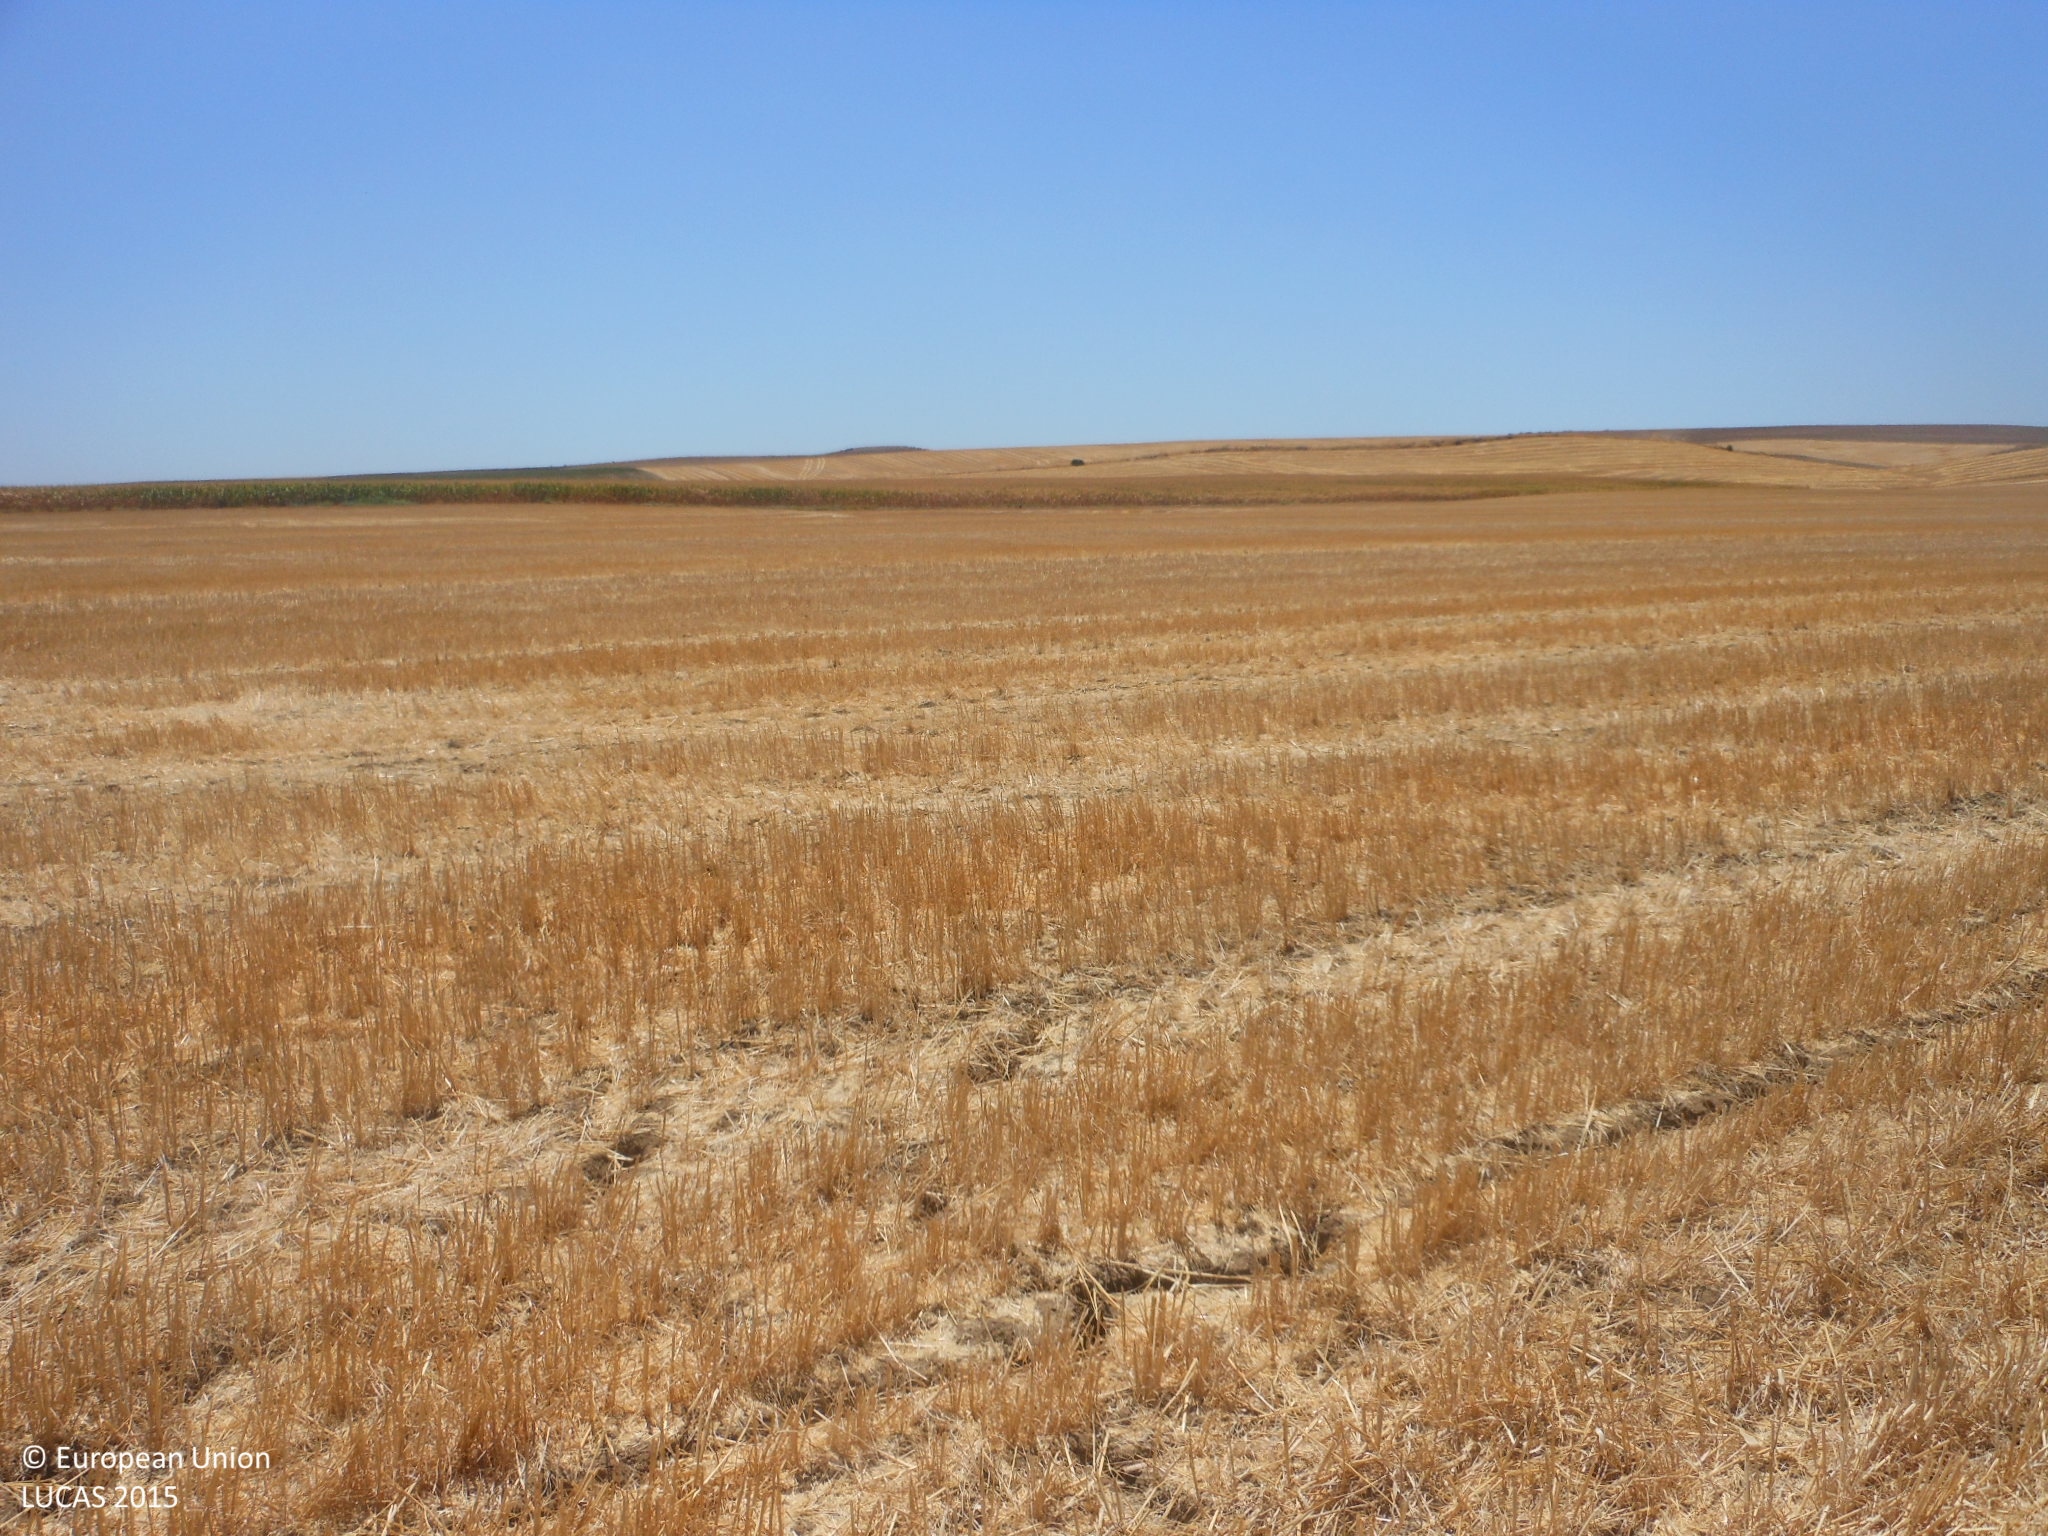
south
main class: Cropland
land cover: Barley
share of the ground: < 10 %
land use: Agriculture (excluding fallow land and kitchen gardens)
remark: Harvested field
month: July
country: ES
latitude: 37.5556
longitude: -5.6082
